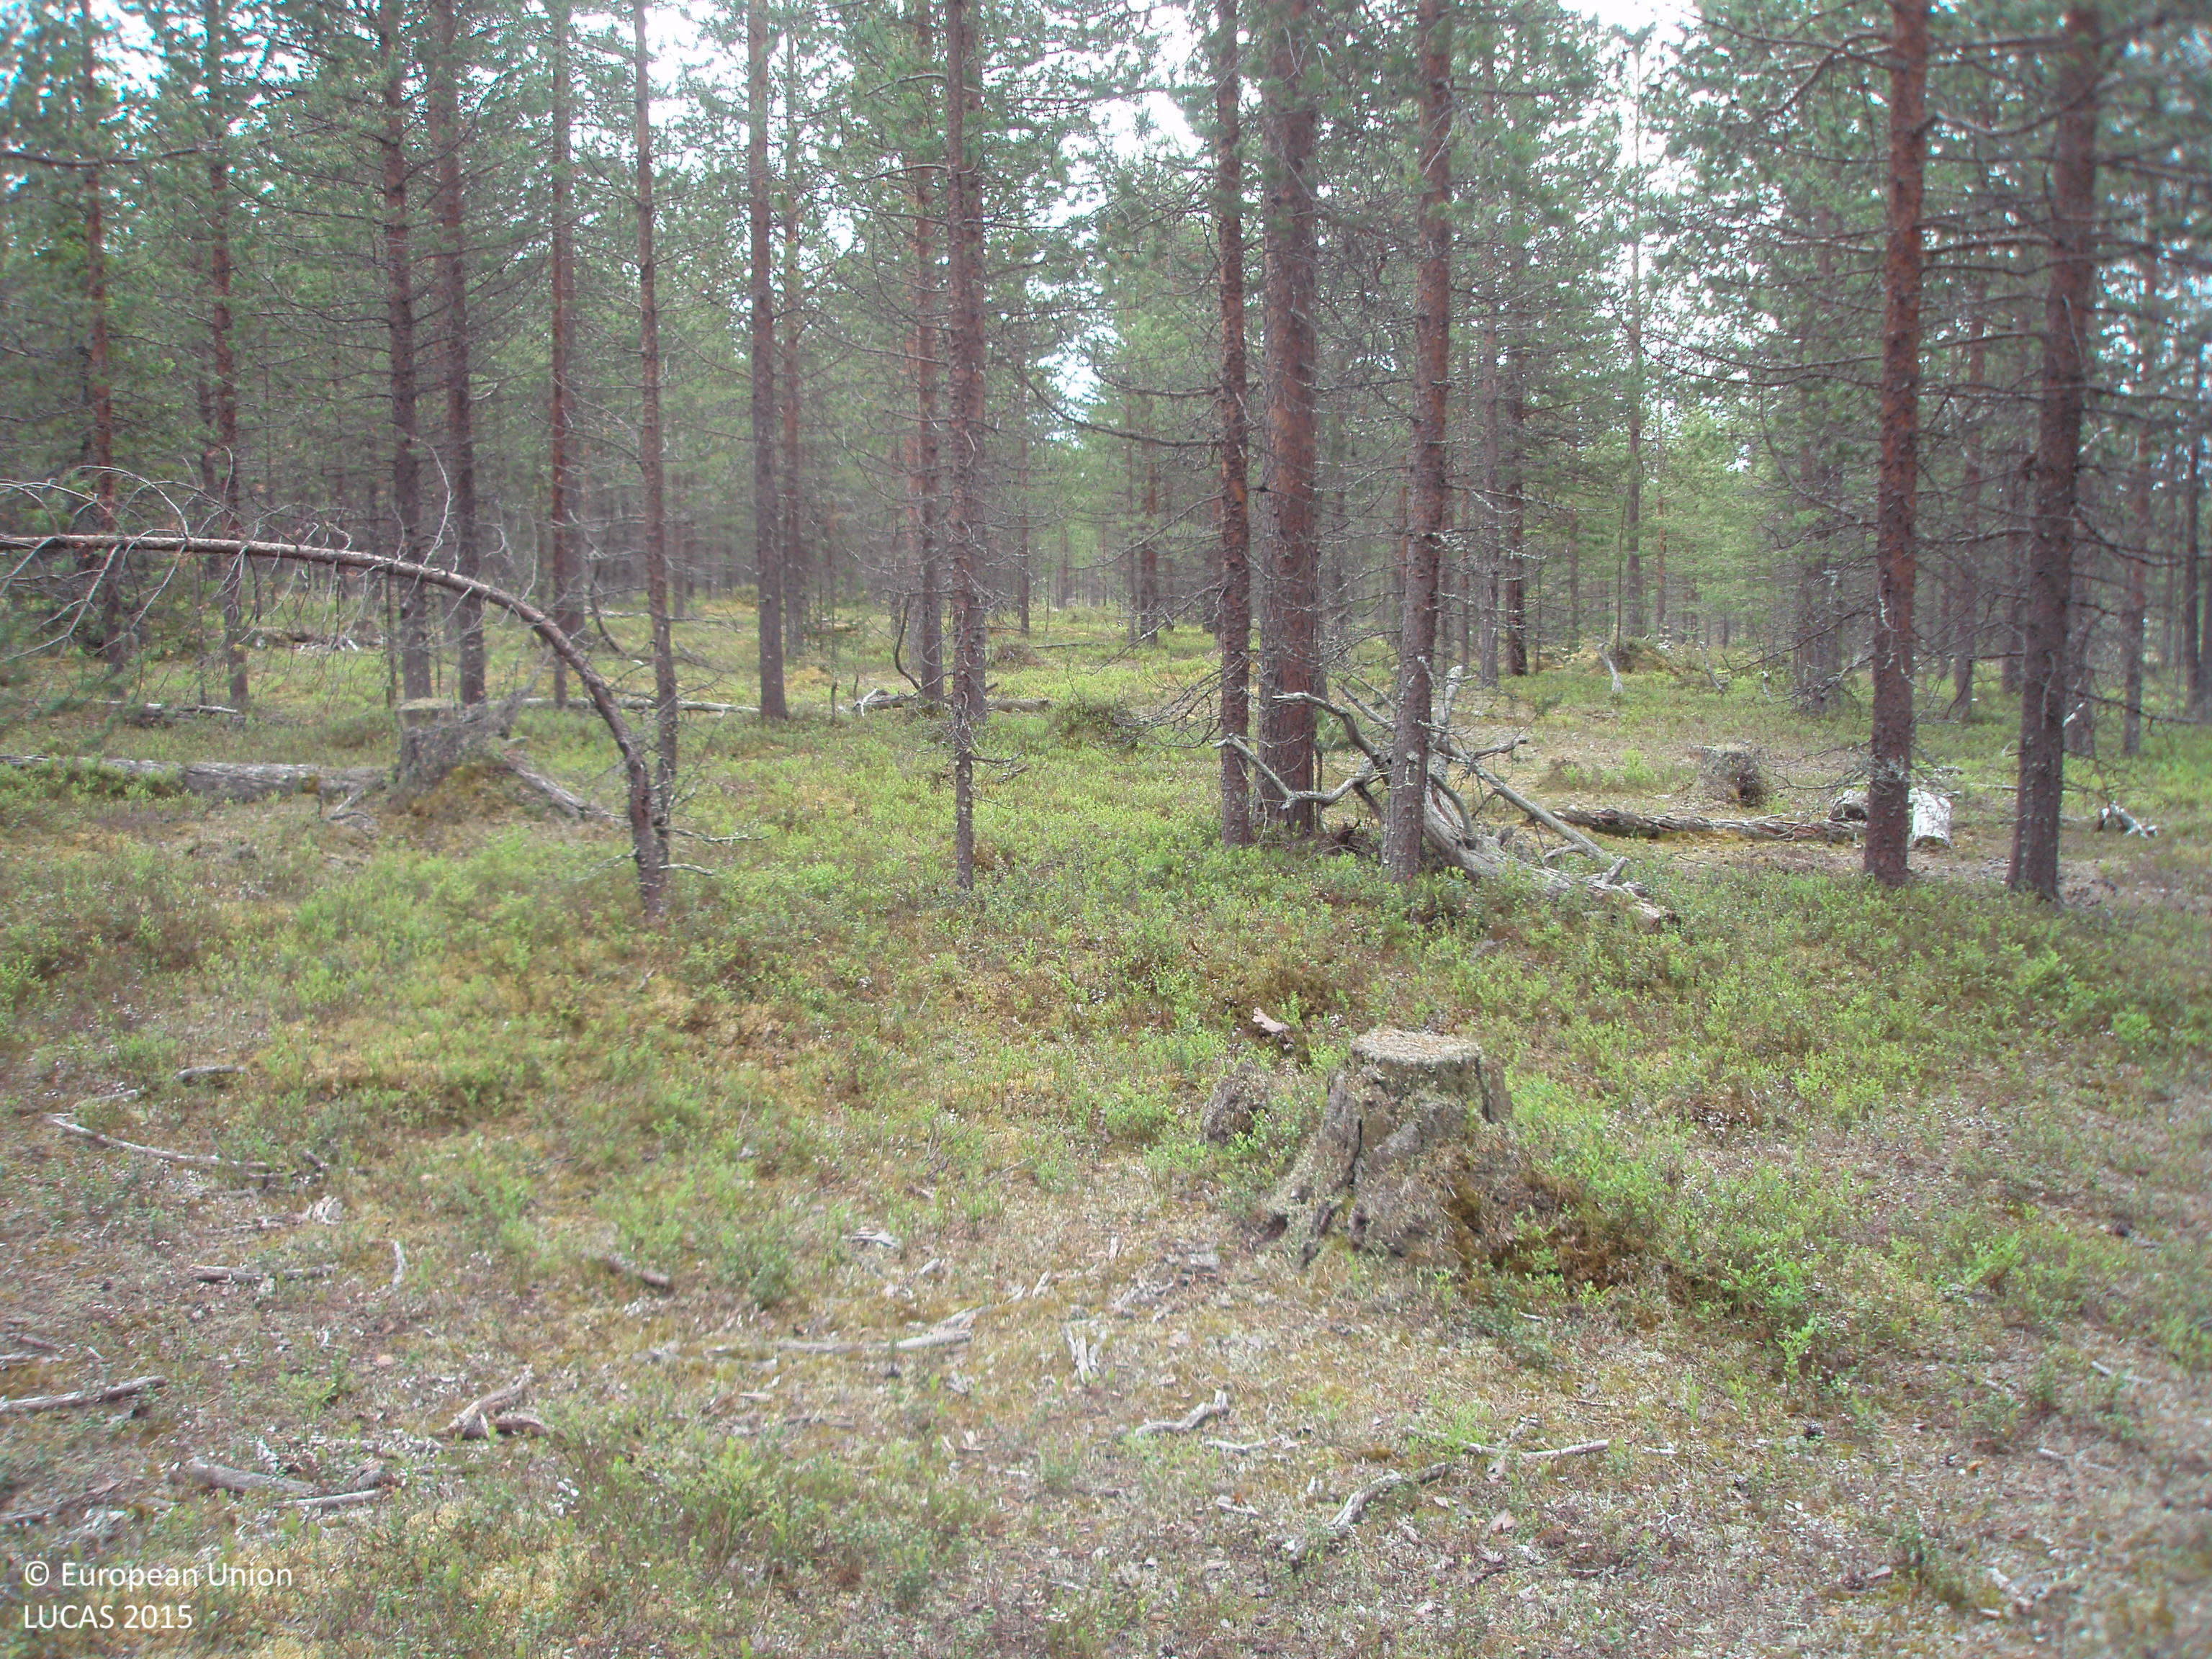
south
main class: Woodland
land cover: Pine dominated coniferous woodland
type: boreal forest
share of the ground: > 75 %
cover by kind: coniferous forest trees 75 %, shrubs 25 %
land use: Forestry
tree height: > 5 m
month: July
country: FI
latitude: 67.7353
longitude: 28.9906
